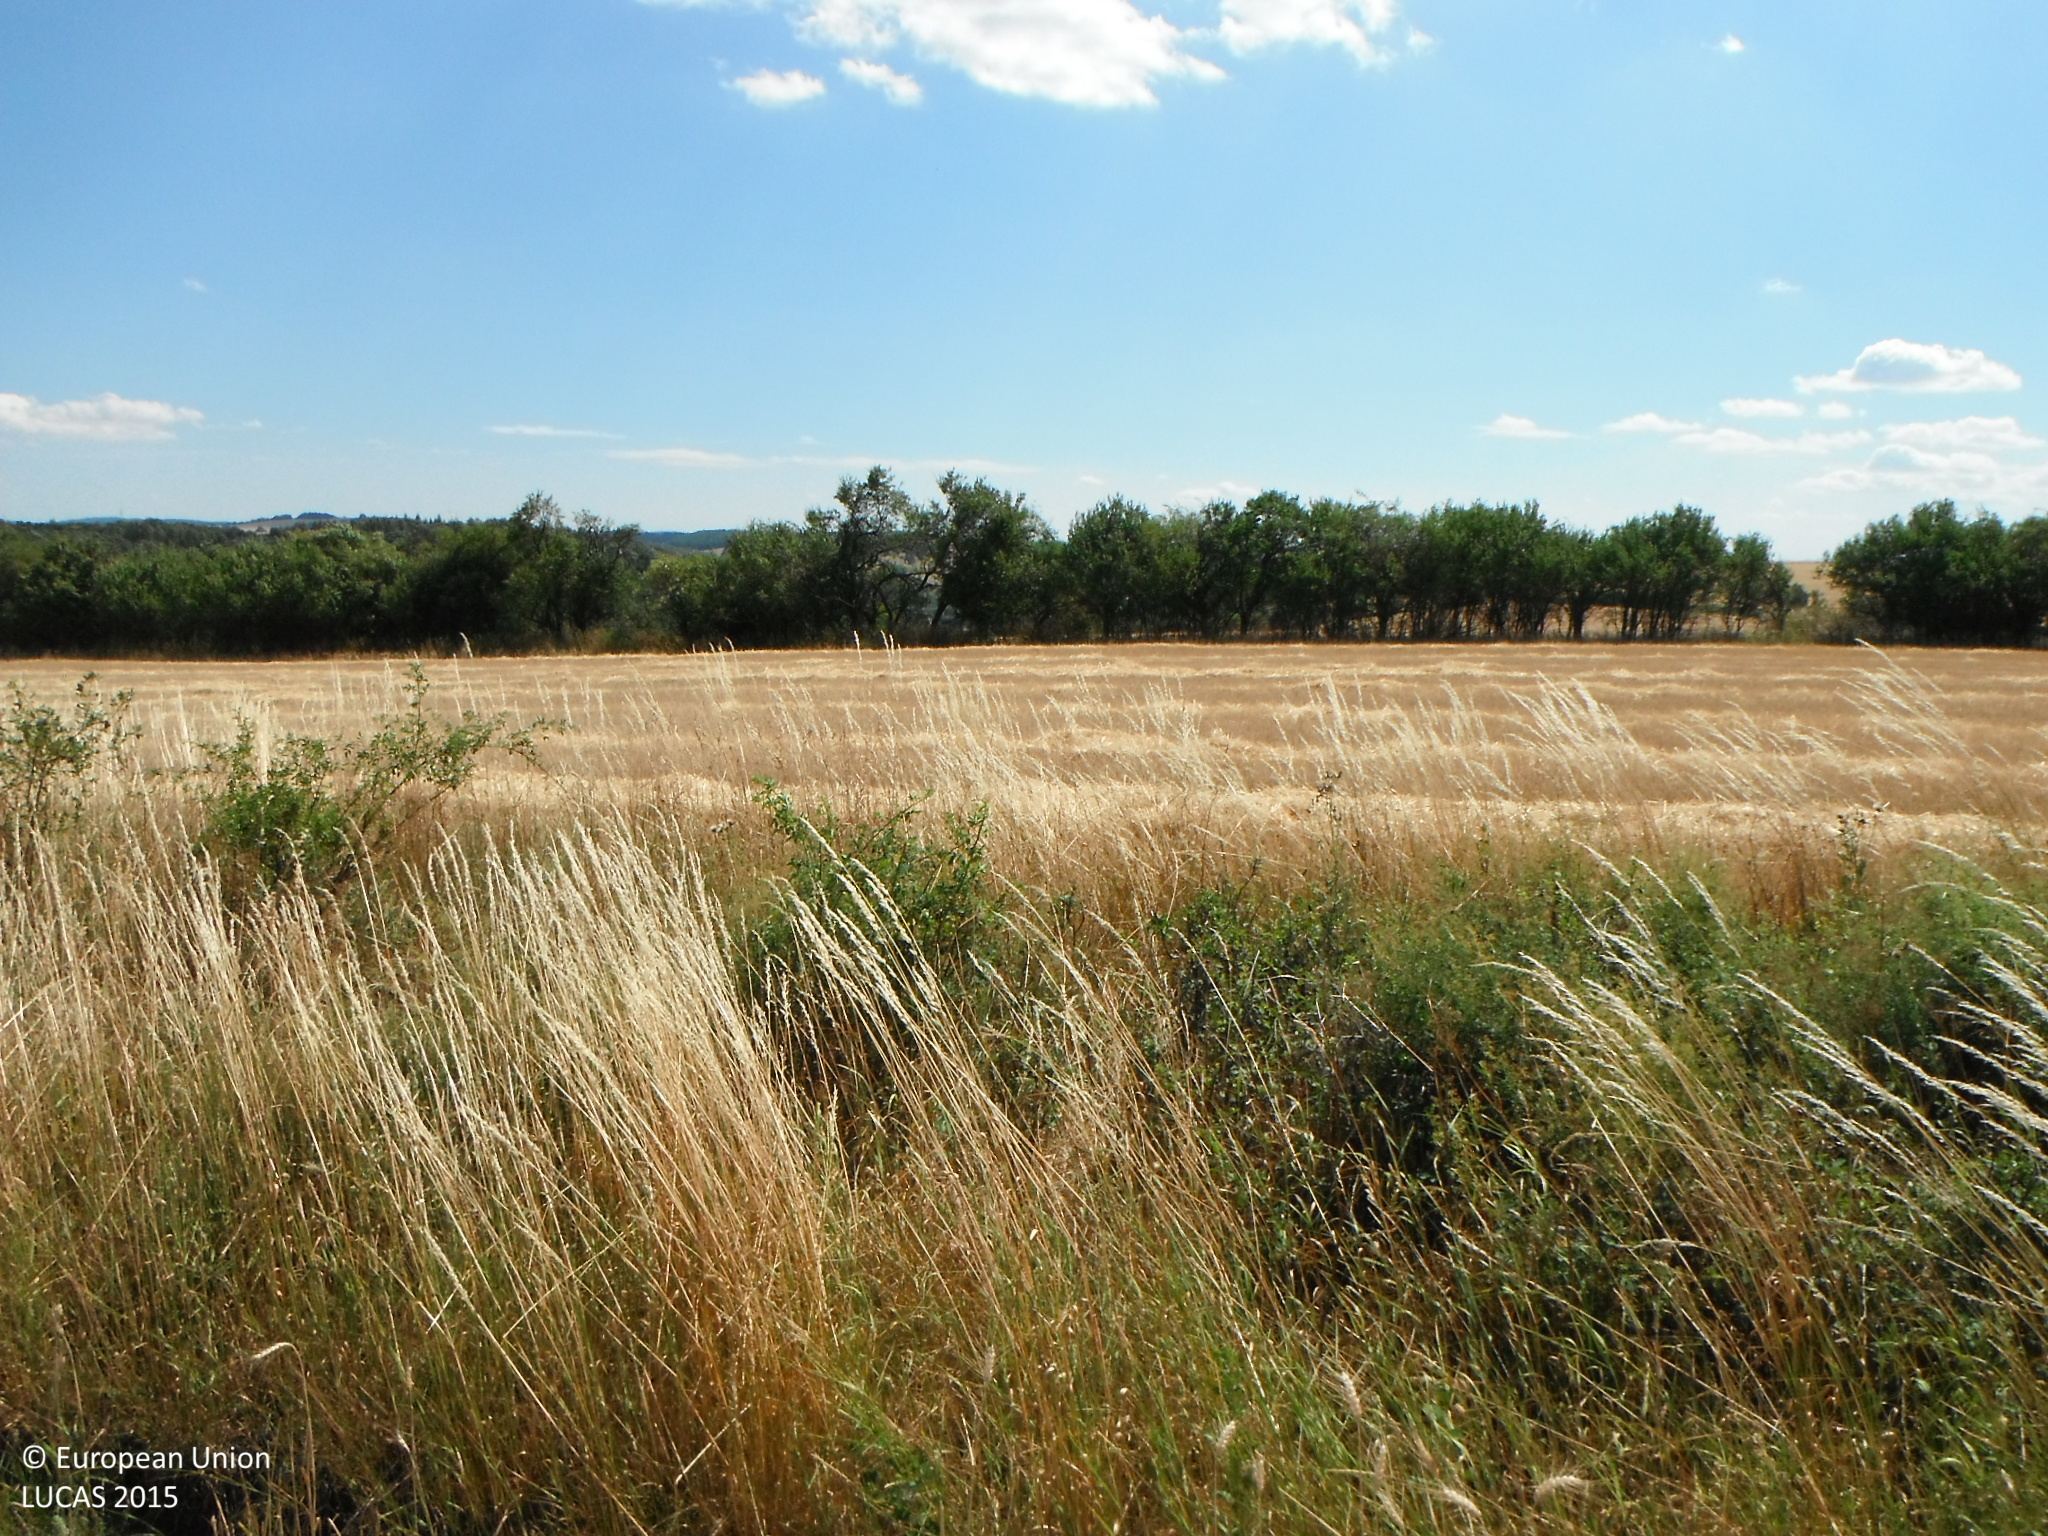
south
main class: Cropland
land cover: Common wheat
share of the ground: > 75 %
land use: Agriculture (excluding fallow land and kitchen gardens)
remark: Harvested field
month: July
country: SK
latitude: 48.3109
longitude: 19.1769
